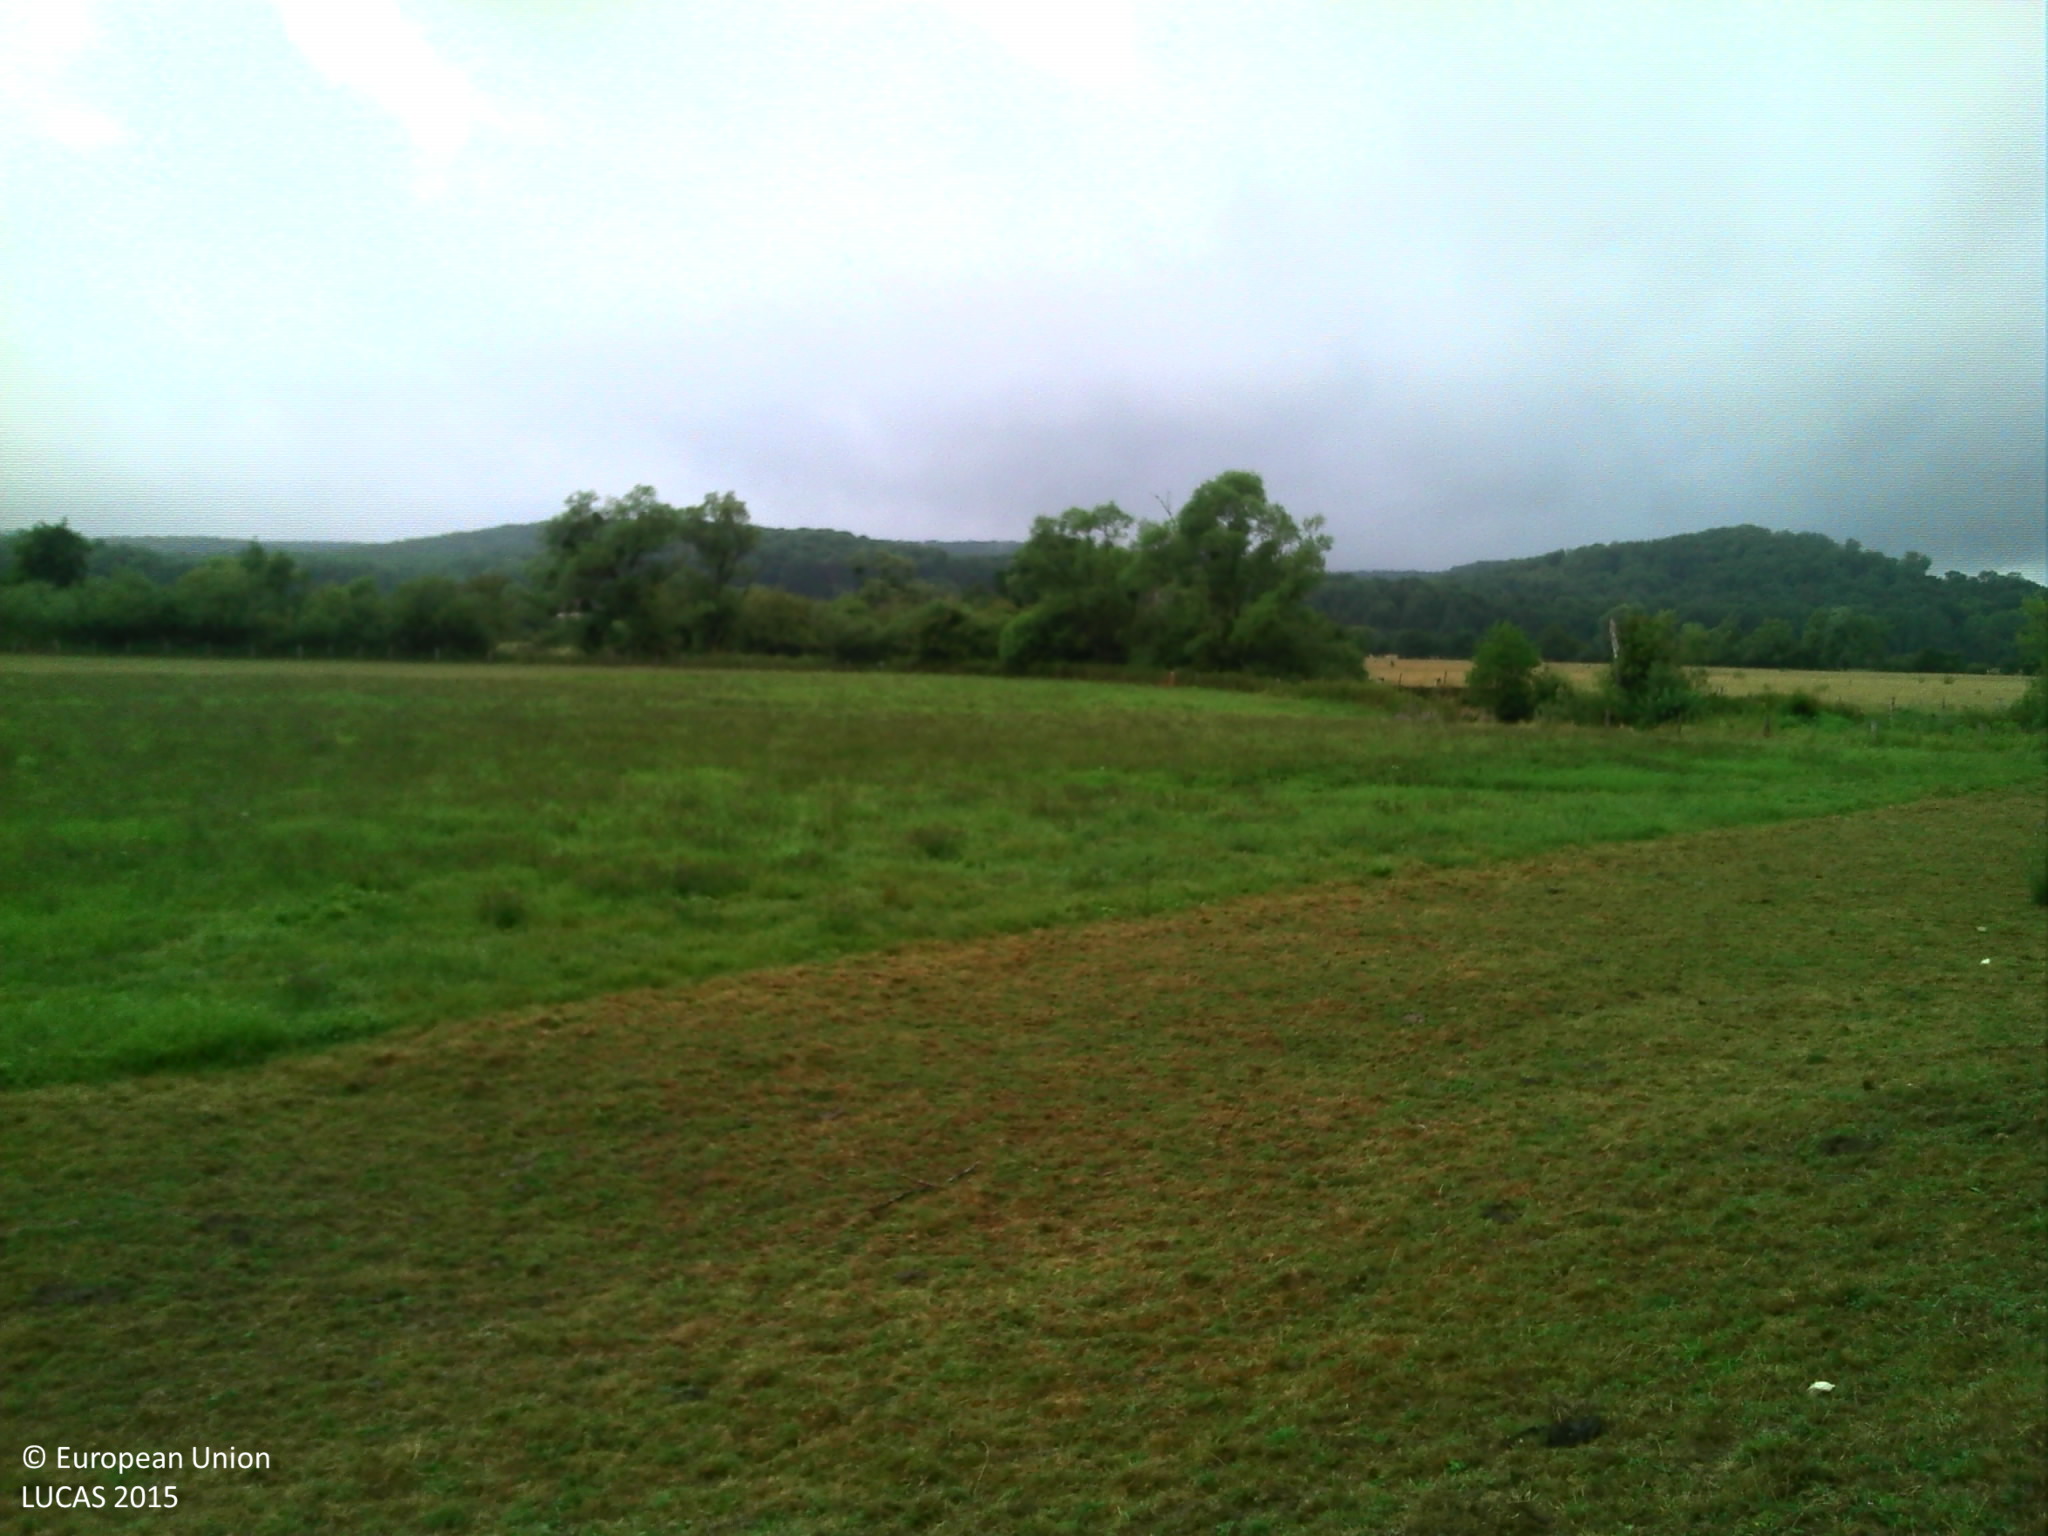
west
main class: Grassland
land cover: Grassland without tree/shrub cover
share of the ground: > 75 %
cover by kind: herbaceous plants 100 %
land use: Agriculture (excluding fallow land and kitchen gardens)
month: July
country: FR
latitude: 49.1757
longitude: 5.0459
